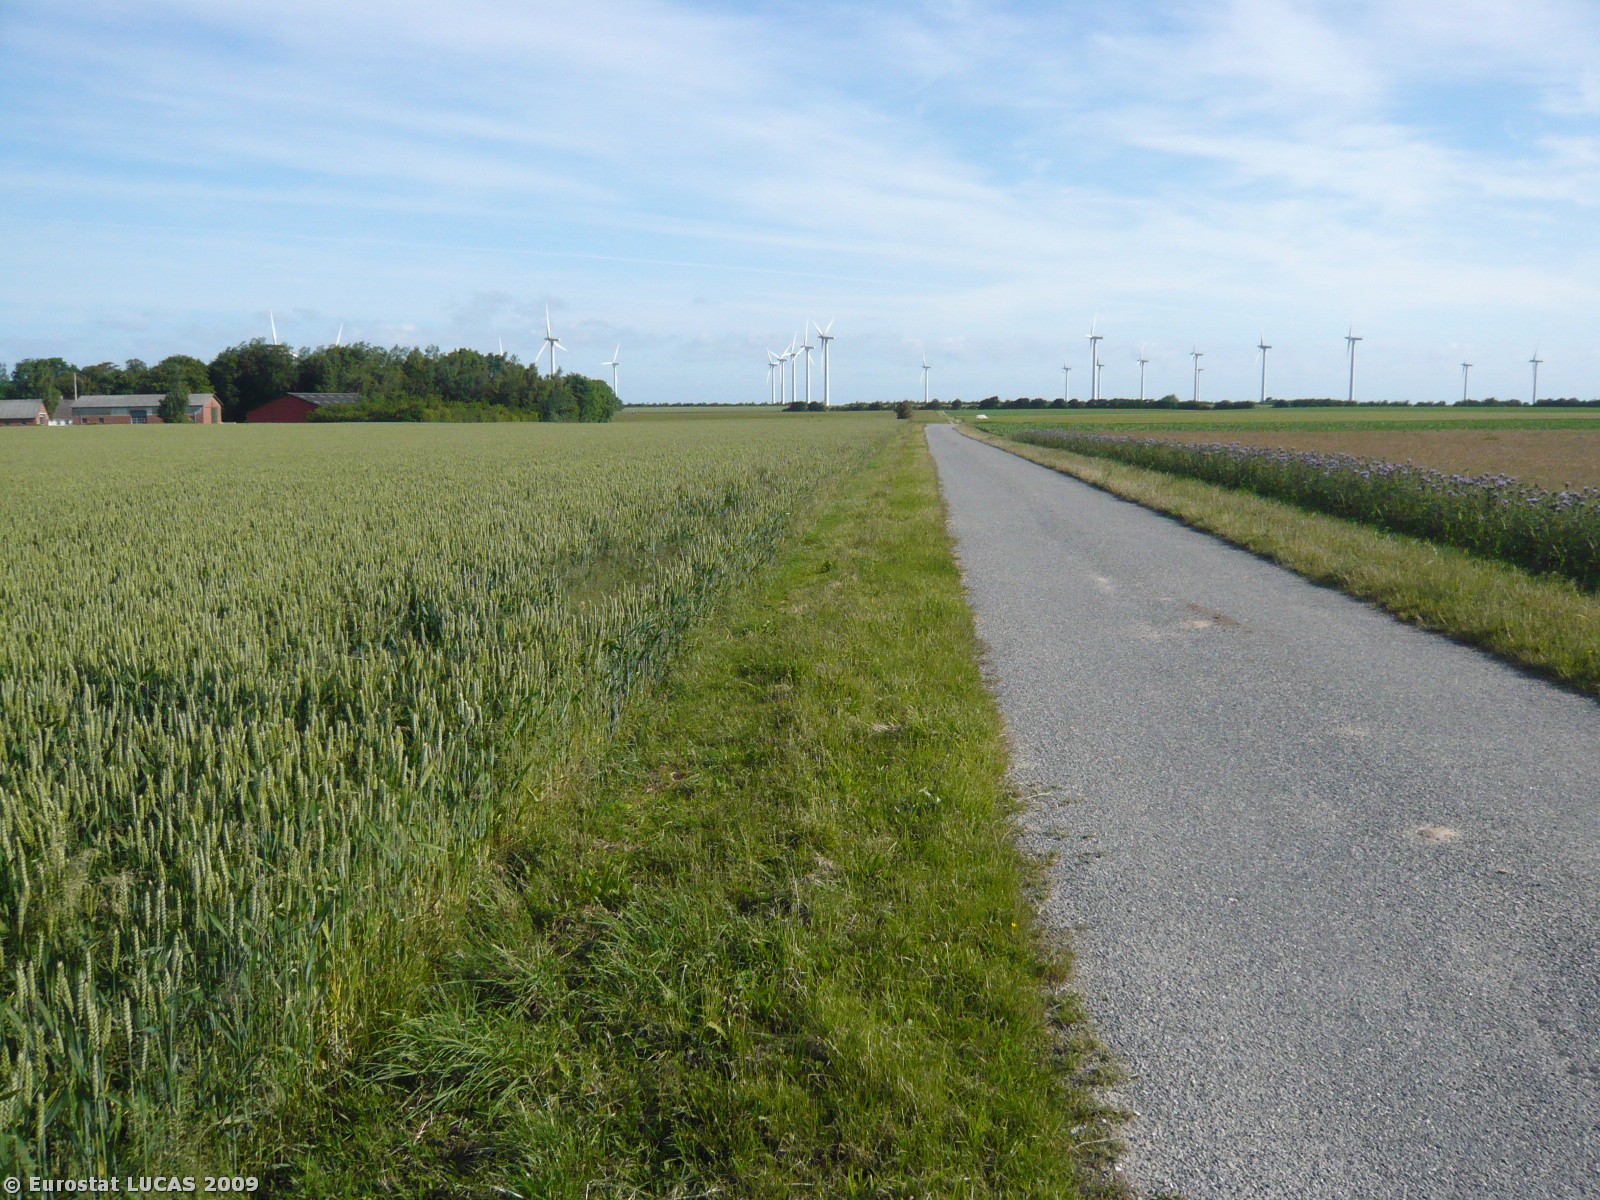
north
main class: Cropland
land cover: Common wheat
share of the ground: > 75 %
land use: Agriculture (excluding fallow land and kitchen gardens)
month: June
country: DK
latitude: 54.9249
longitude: 11.0759
